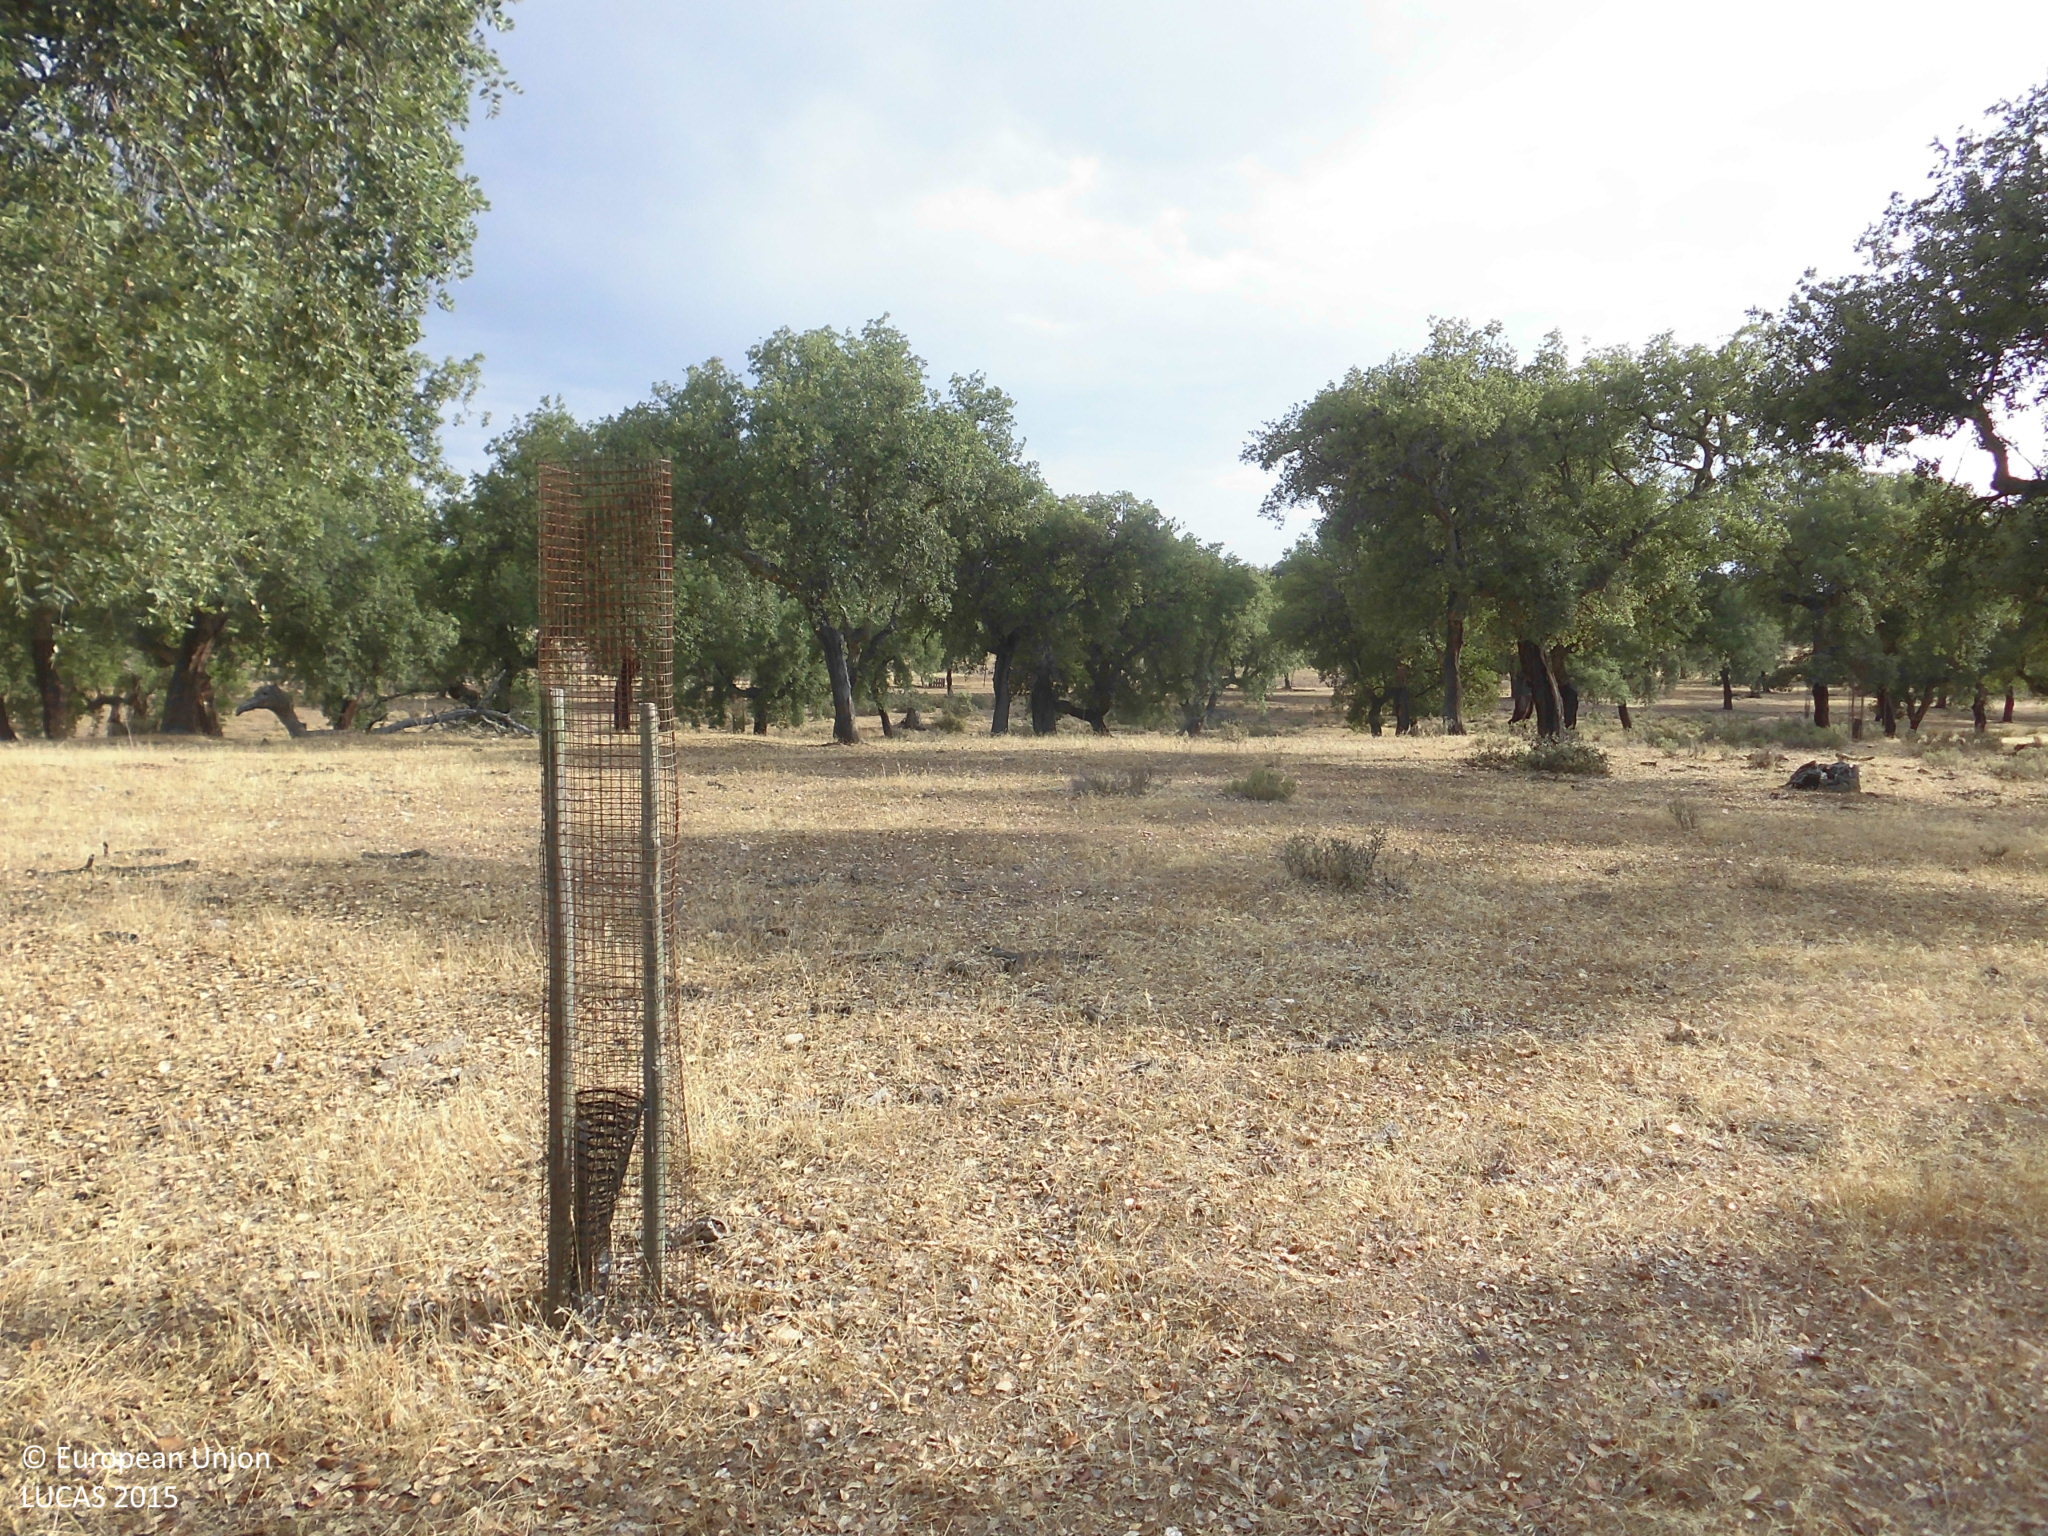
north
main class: Woodland
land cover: Broadleaved woodland
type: broadleaved evergreen forest
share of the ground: 25 - 50 %
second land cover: Grassland without tree/shrub cover
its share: > 75 %
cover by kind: herbaceous plants 60 %, broadleaved forest trees 40 %
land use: Forestry
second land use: Agriculture (excluding fallow land and kitchen gardens)
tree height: > 5 m
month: July
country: ES
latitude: 39.8482
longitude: -5.8775
